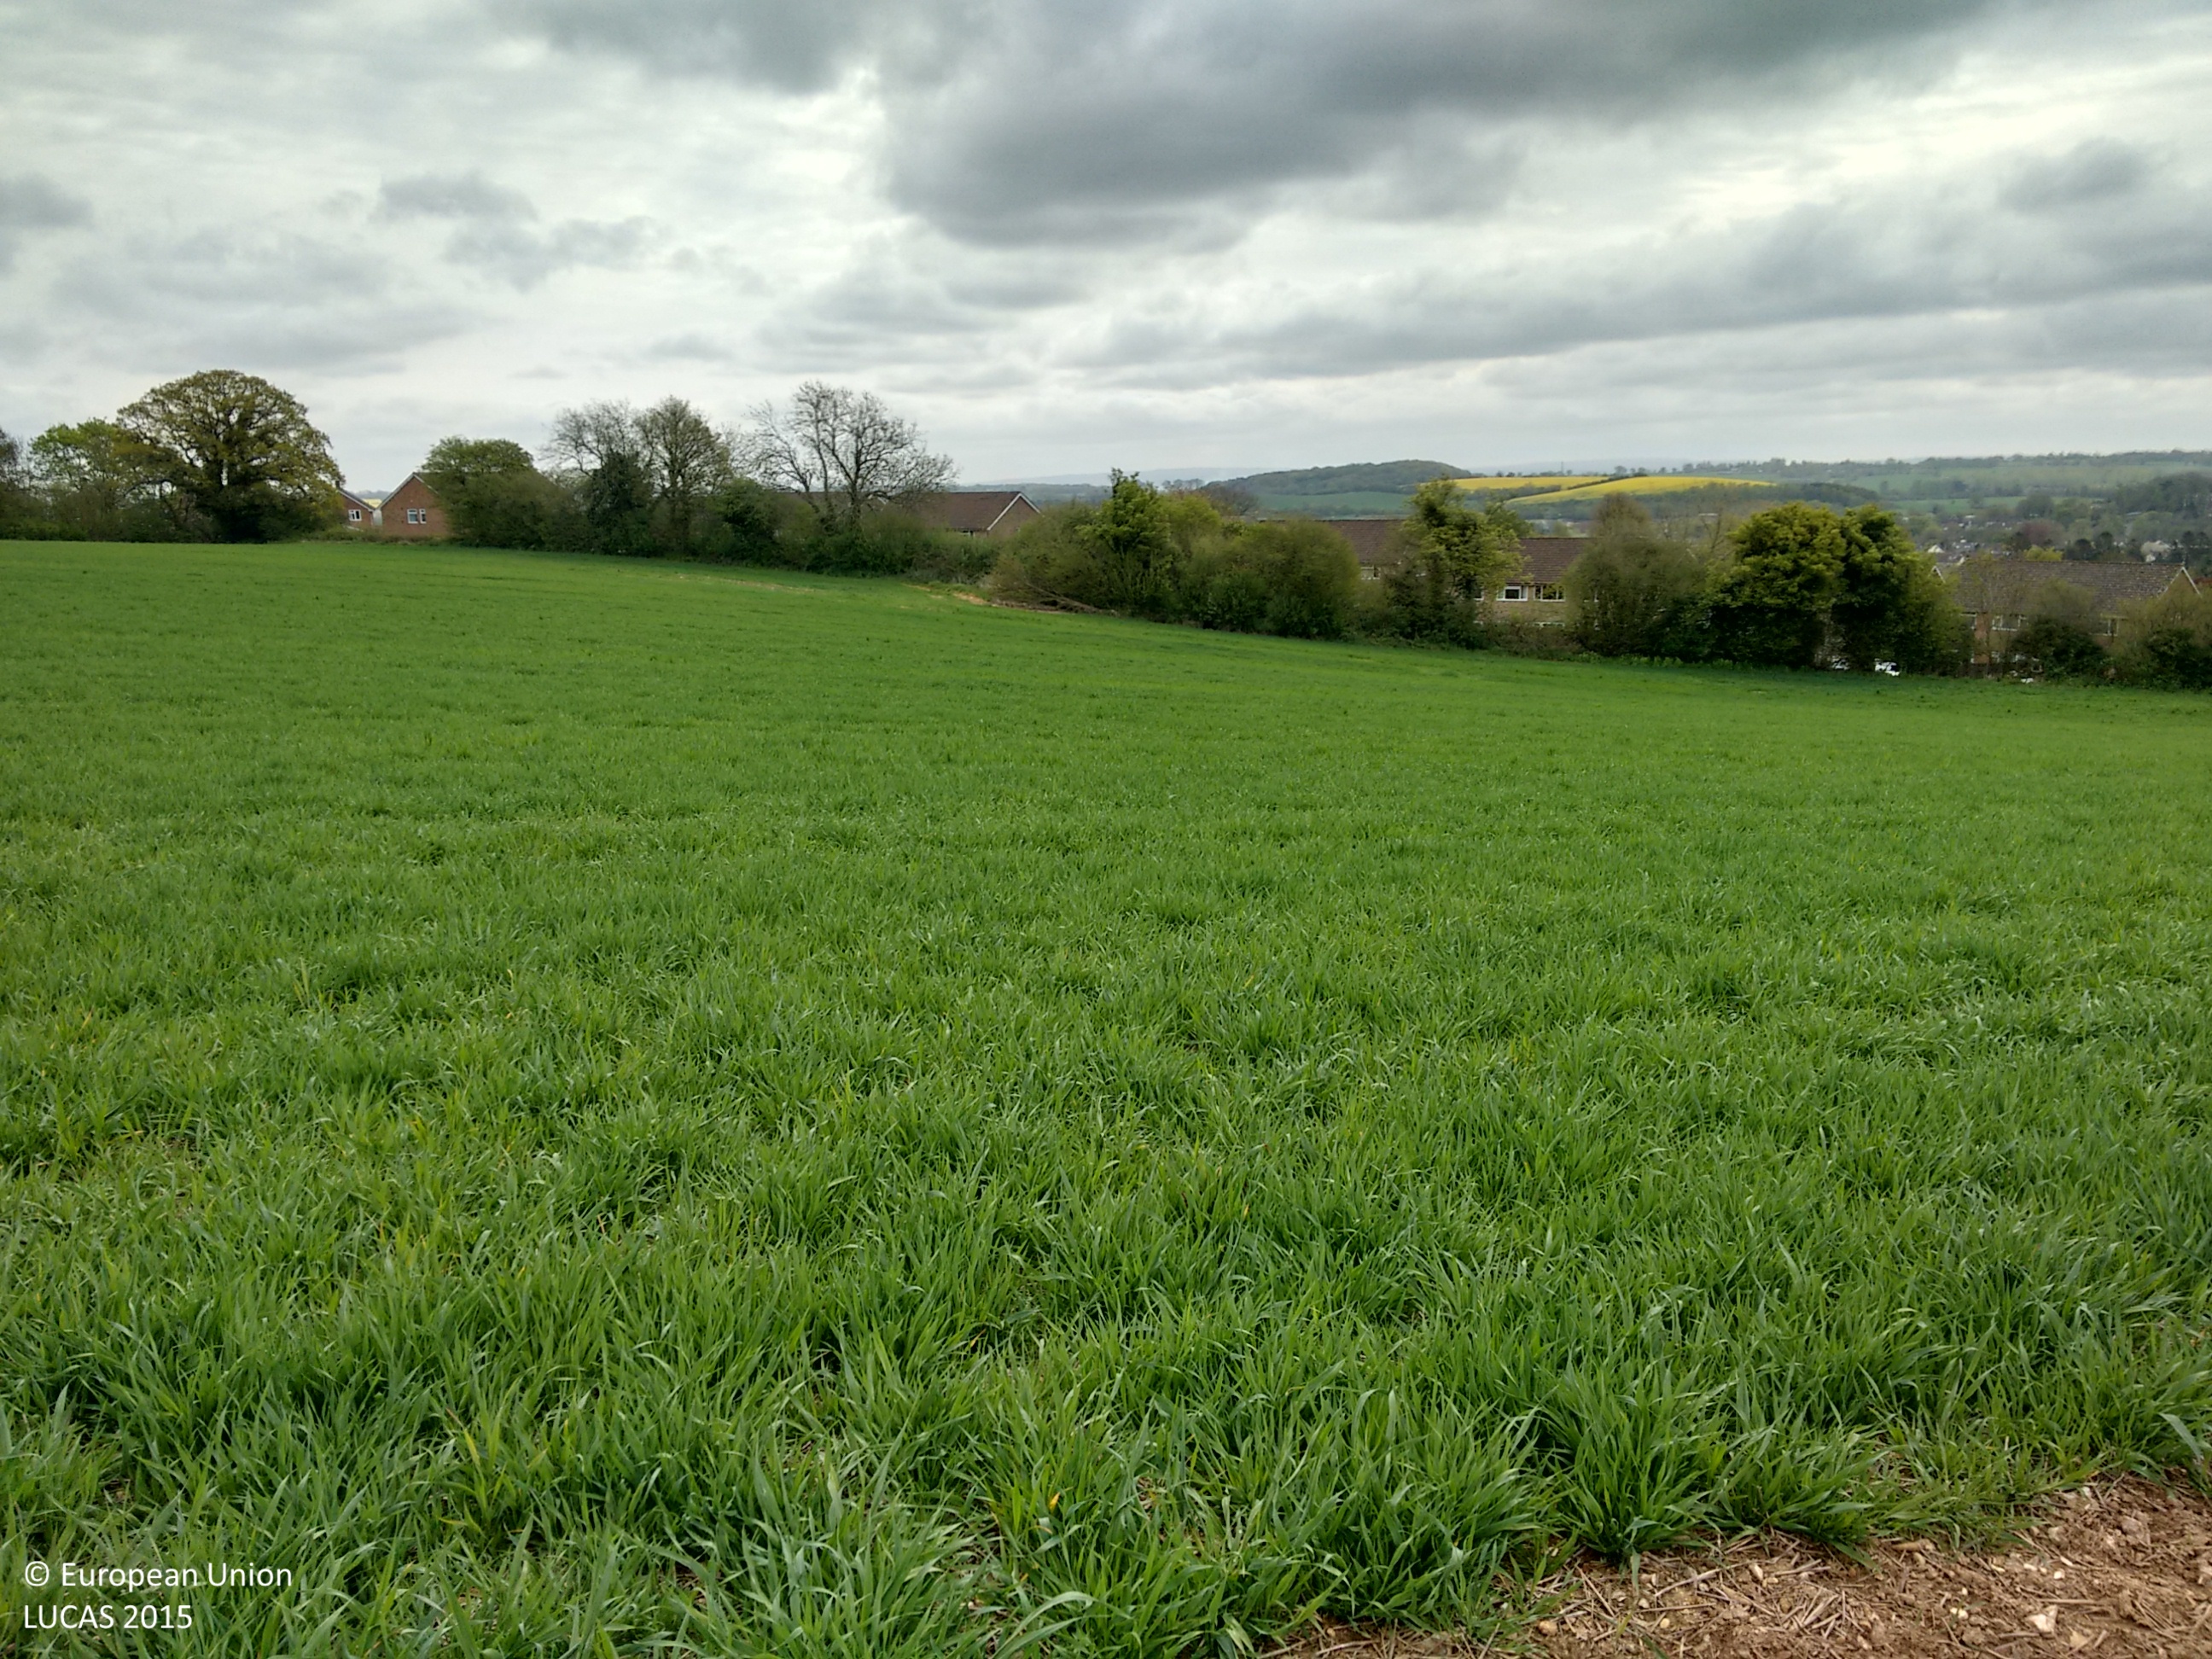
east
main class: Cropland
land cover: Oats
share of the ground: 50 - 75 %
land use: Agriculture (excluding fallow land and kitchen gardens)
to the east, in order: Oats; Abandoned hedges; Artificial constructions in urban areas
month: May
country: GB
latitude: 51.1584
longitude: -0.9826
